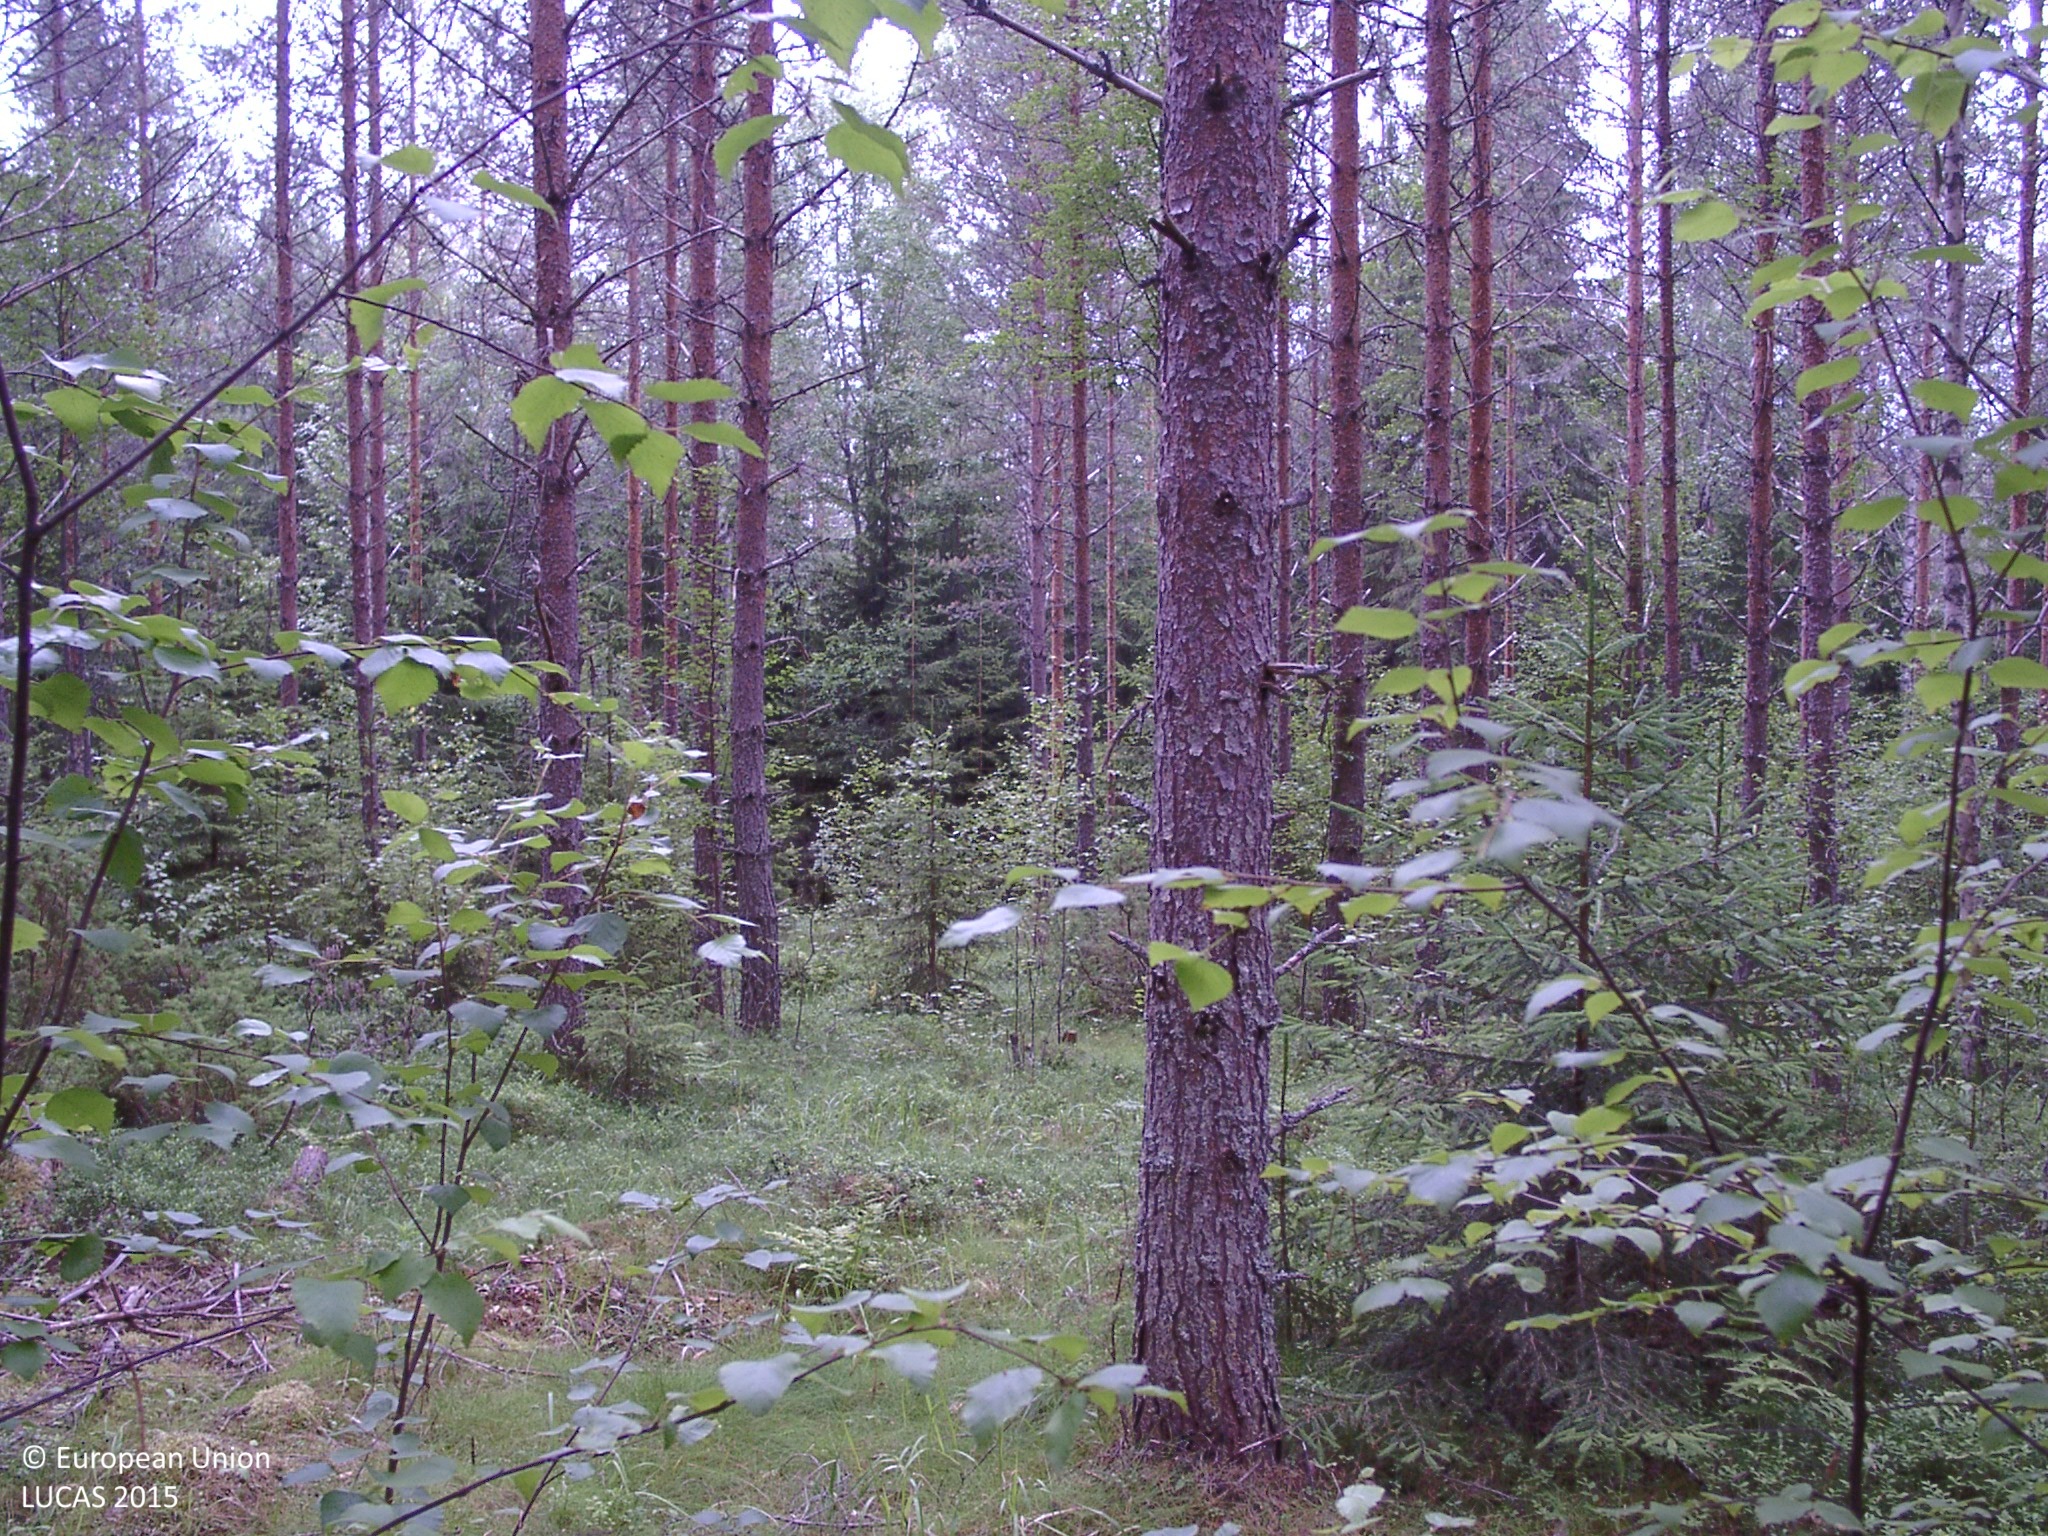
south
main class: Woodland
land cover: Other mixed woodland
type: boreal forest
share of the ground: > 75 %
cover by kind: coniferous forest trees 60 %, broadleaved forest trees 20 %, shrubs 10 %, herbaceous plants 5 %, lichens and mosses 5 %
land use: Forestry
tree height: > 5 m
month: July
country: FI
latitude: 62.2652
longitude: 25.3067
